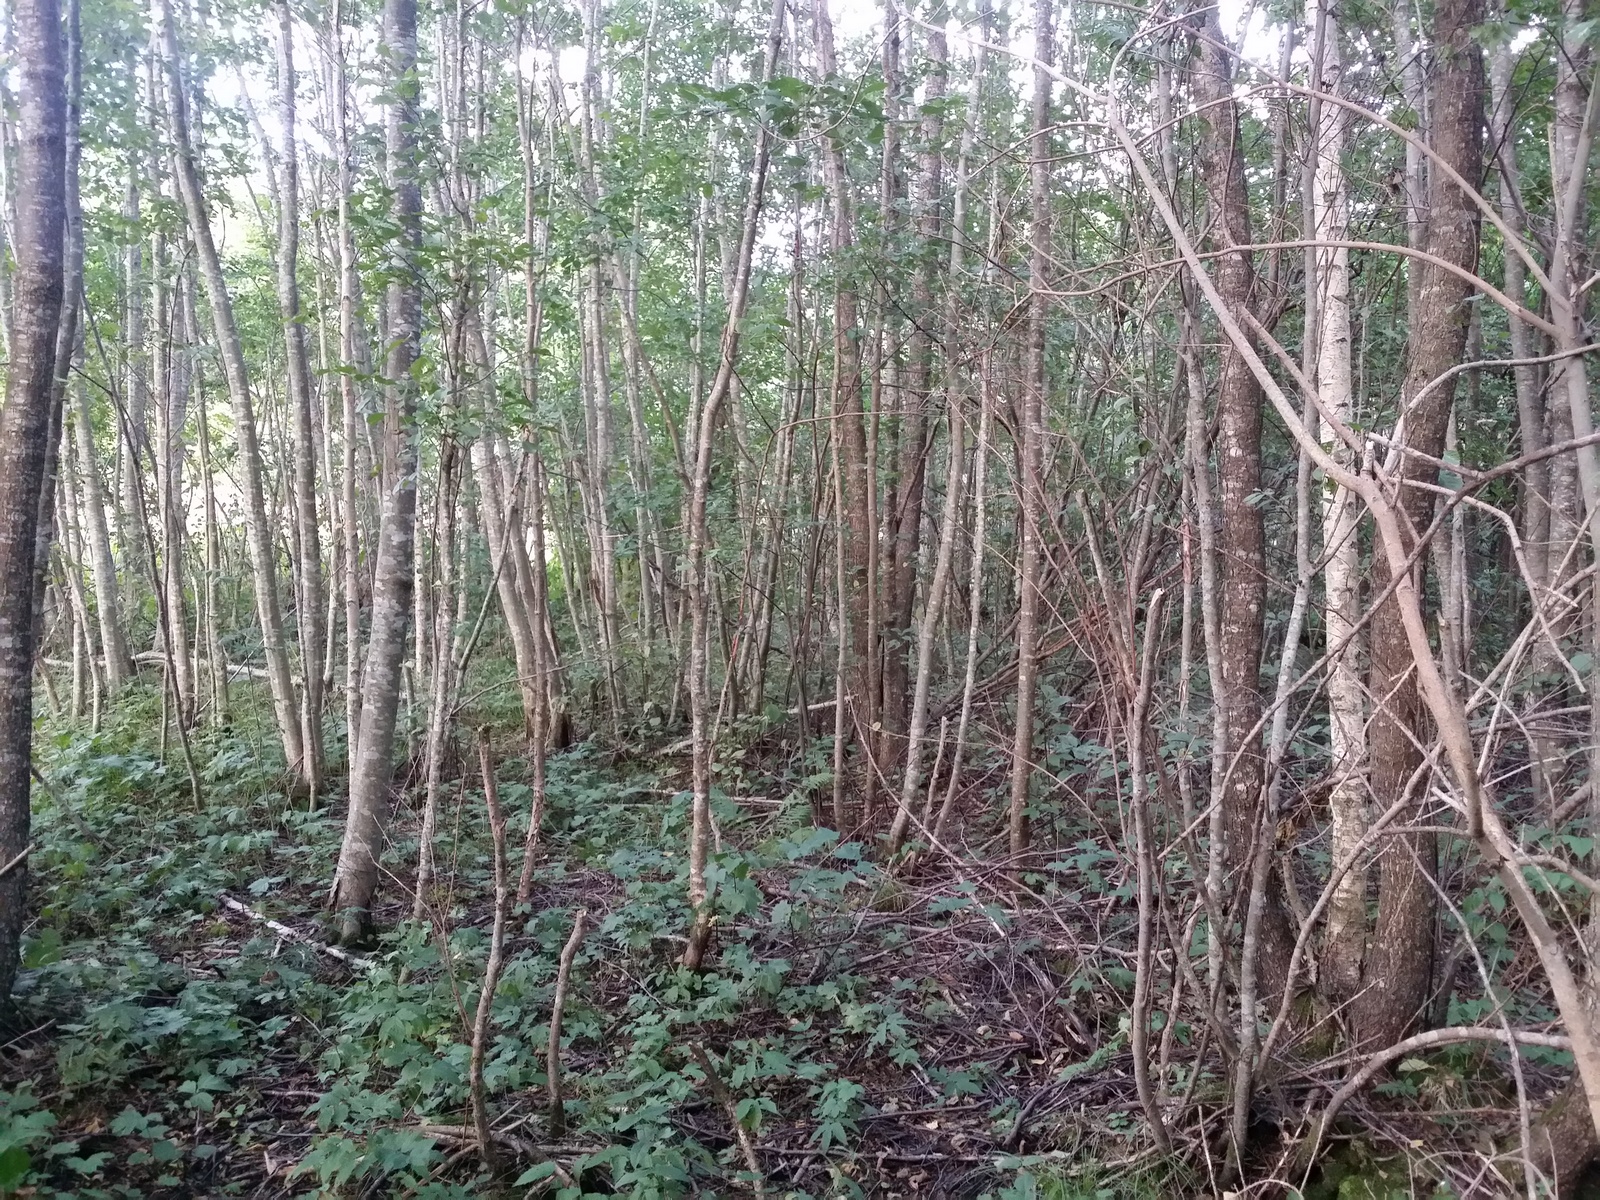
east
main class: Woodland
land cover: Broadleaved woodland
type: non-riverine alder, birch or aspen forest
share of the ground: > 75 %
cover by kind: broadleaved forest trees 85 %, herbaceous plants 10 %, unconsolidated bare surface 5 %
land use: Forestry
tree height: > 5 m
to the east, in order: Broadleaved woodland
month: August
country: LV
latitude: 57.2337
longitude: 27.6930
